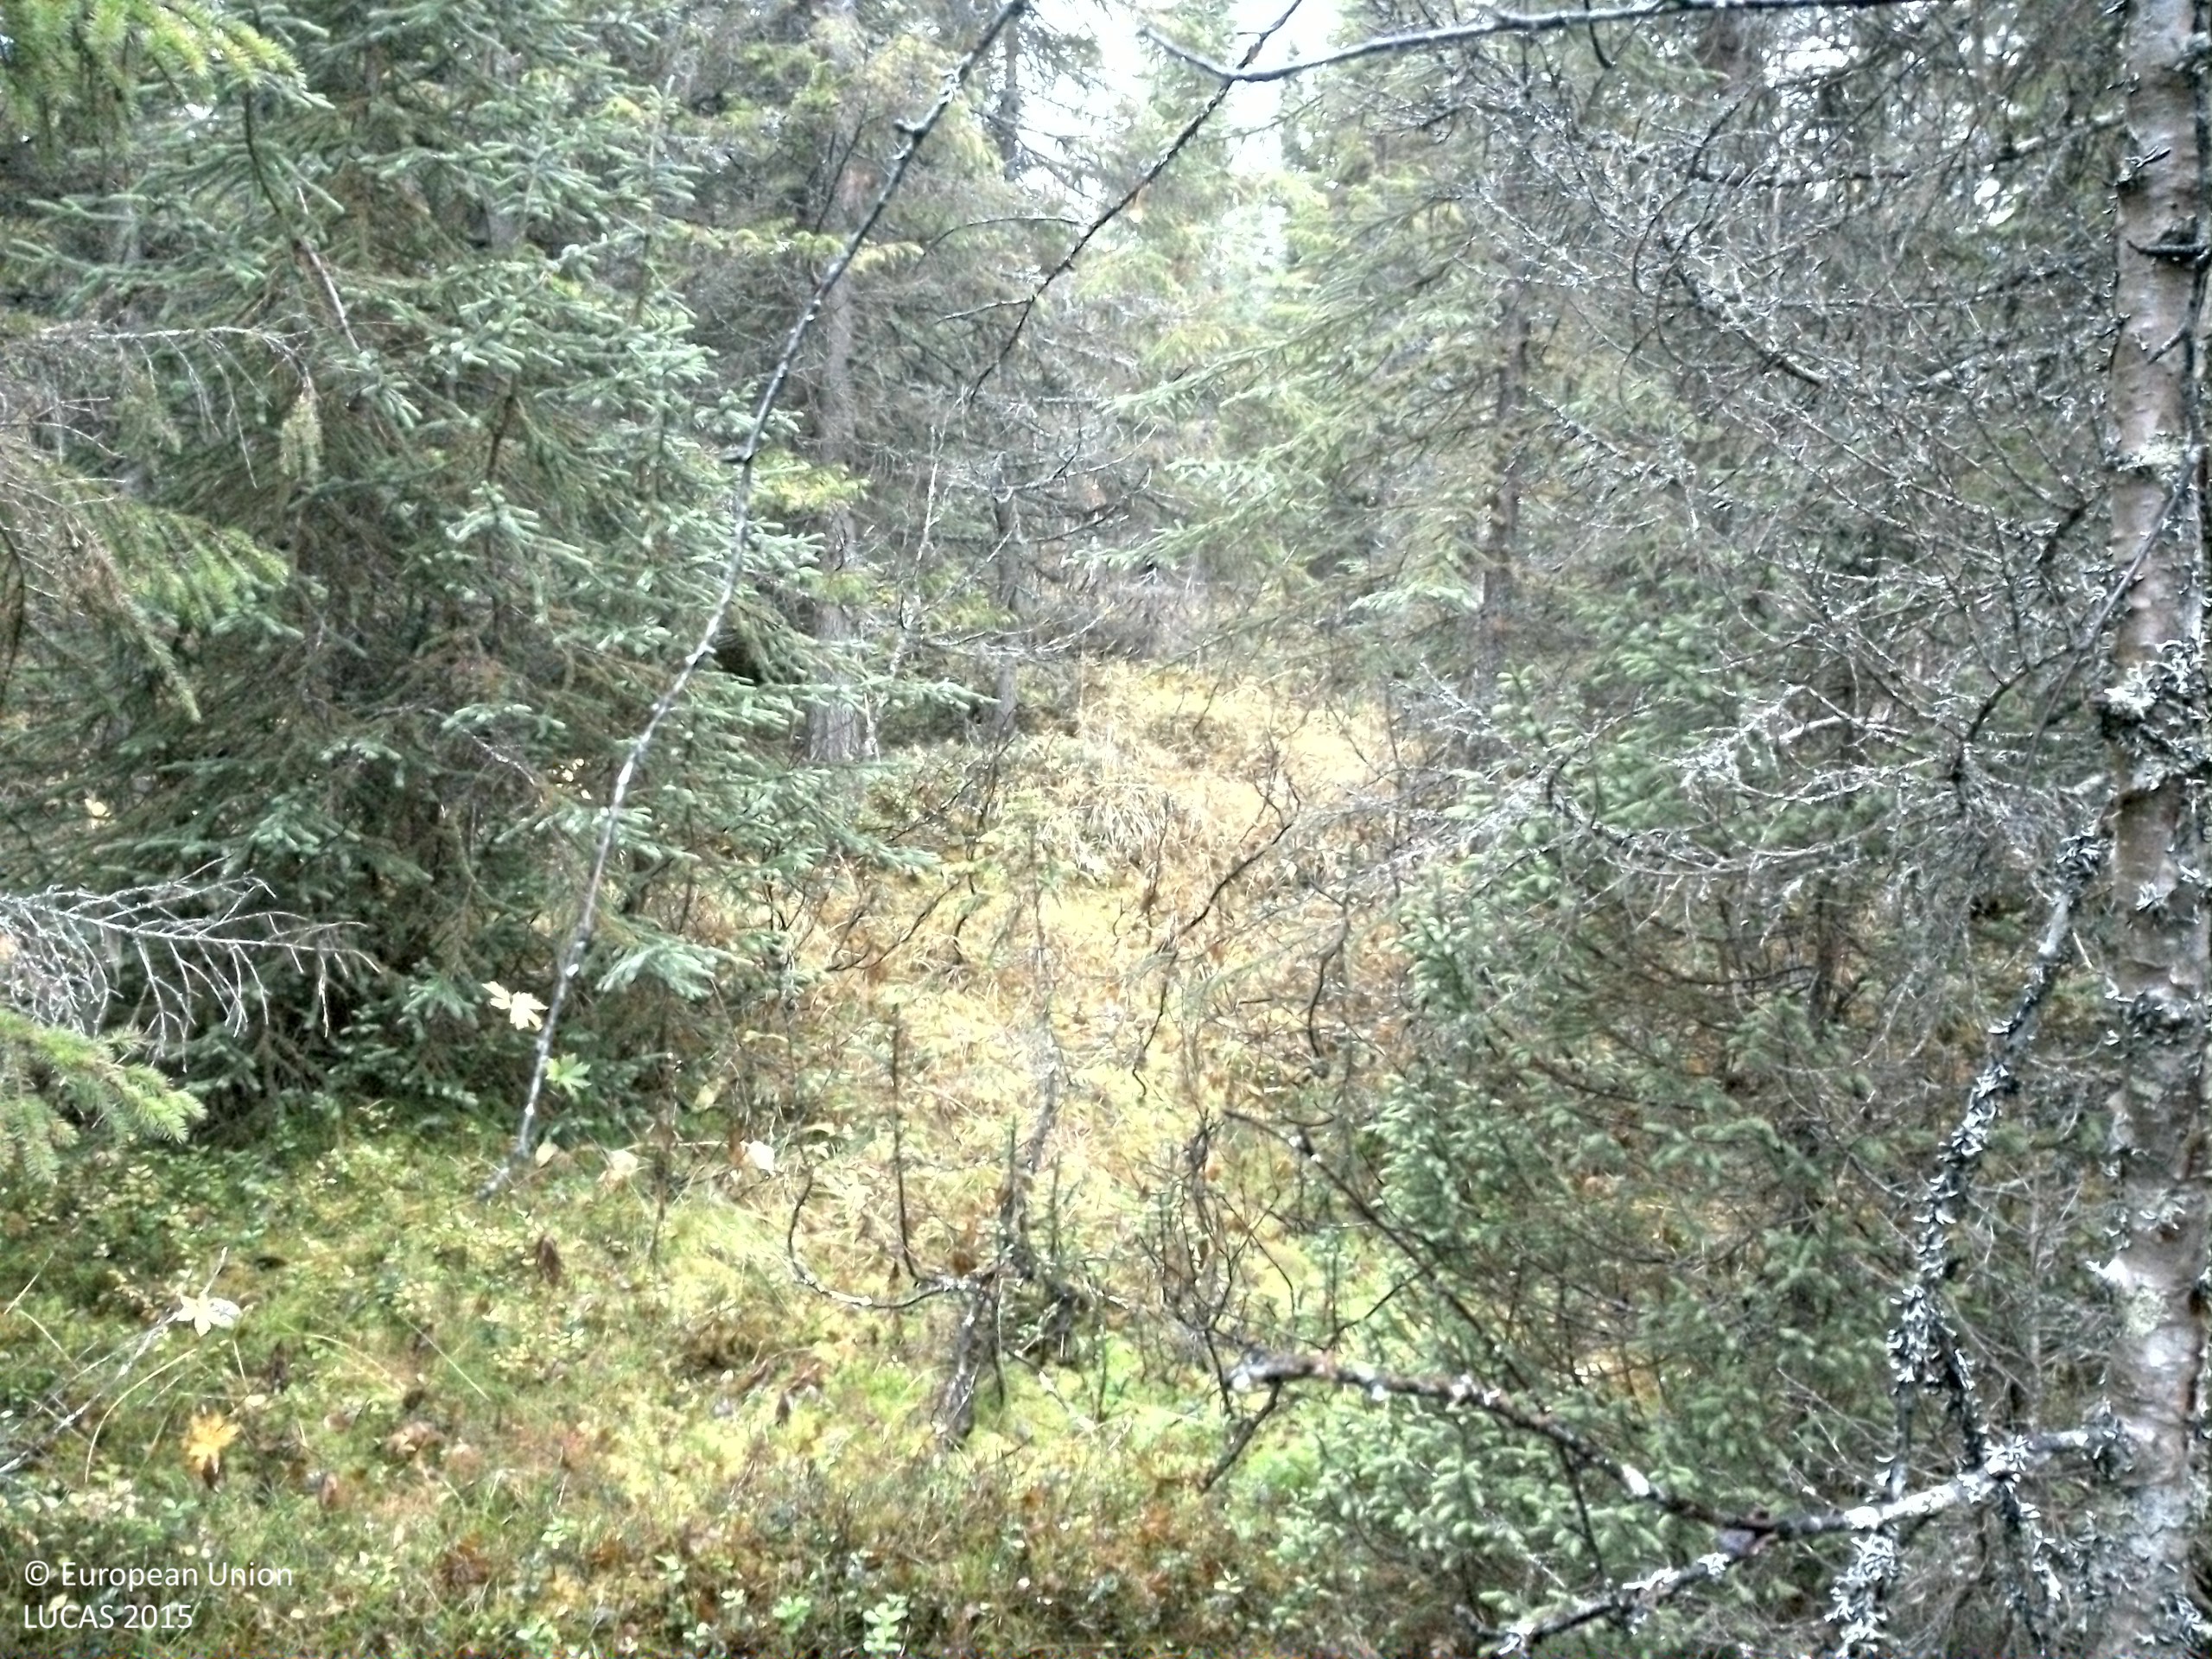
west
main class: Woodland
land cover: Spruce dominated coniferous woodland
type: boreal forest
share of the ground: > 75 %
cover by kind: coniferous forest trees 60 %, broadleaved forest trees 15 %, shrubs 15 %, lichens and mosses 10 %
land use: Forestry
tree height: > 5 m
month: October
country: SE
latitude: 64.6164
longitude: 14.0938
